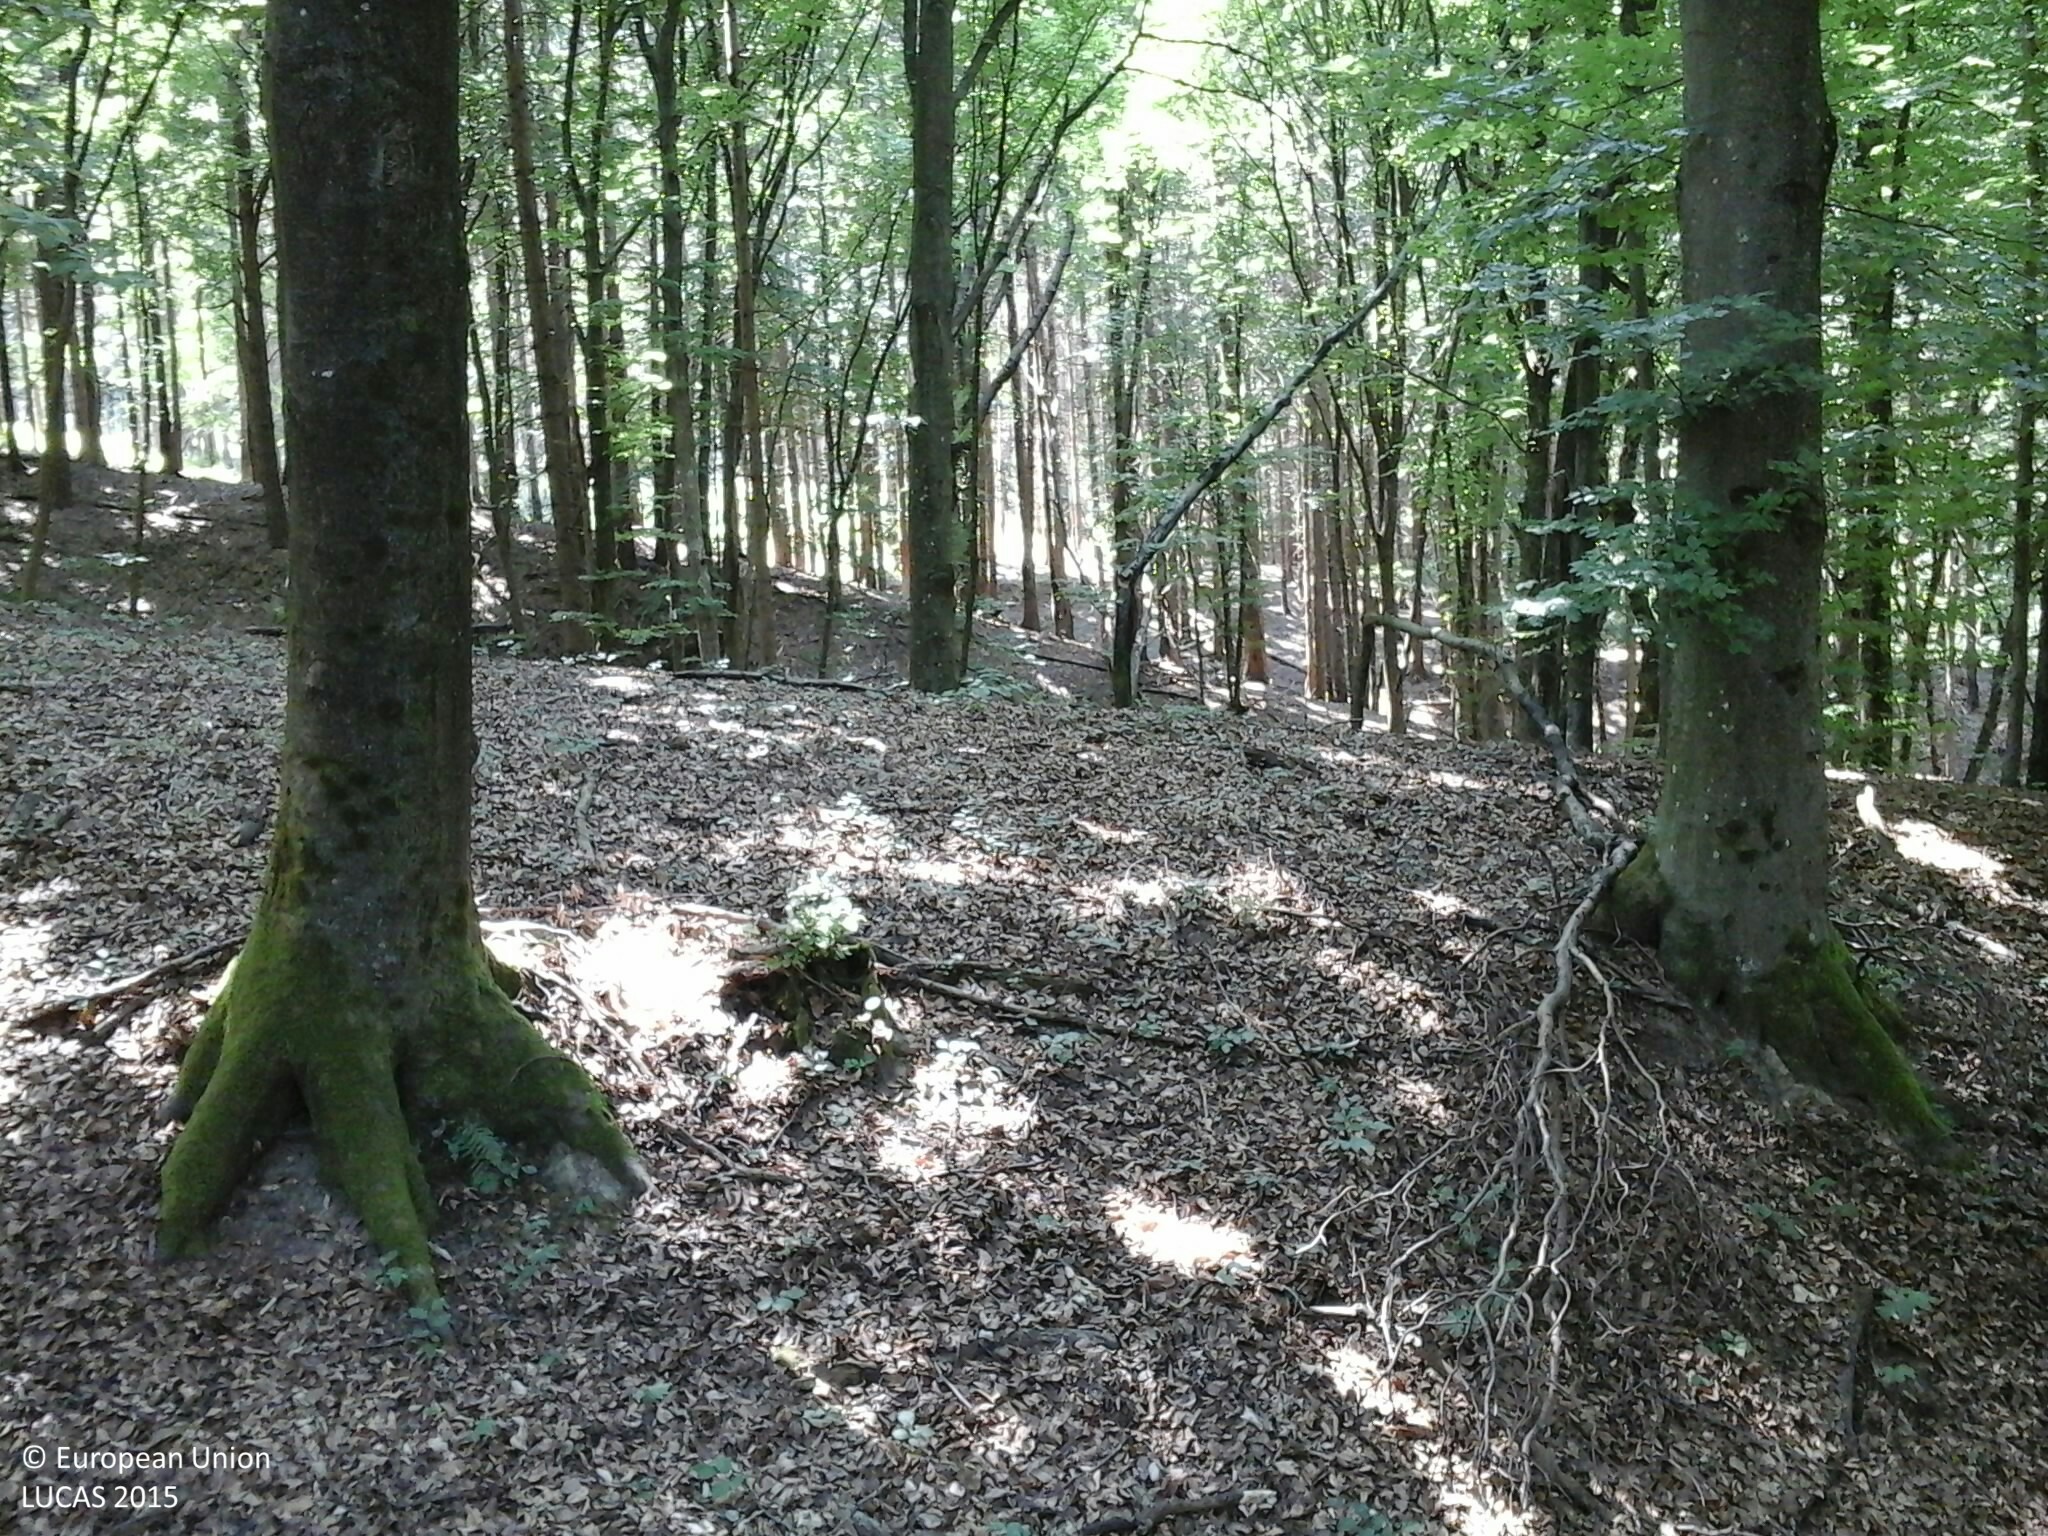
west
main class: Woodland
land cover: Spruce dominated coniferous woodland
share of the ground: > 75 %
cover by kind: coniferous forest trees 90 %, broadleaved forest trees 10 %
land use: Forestry
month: July
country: HU
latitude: 46.9347
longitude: 16.4252
